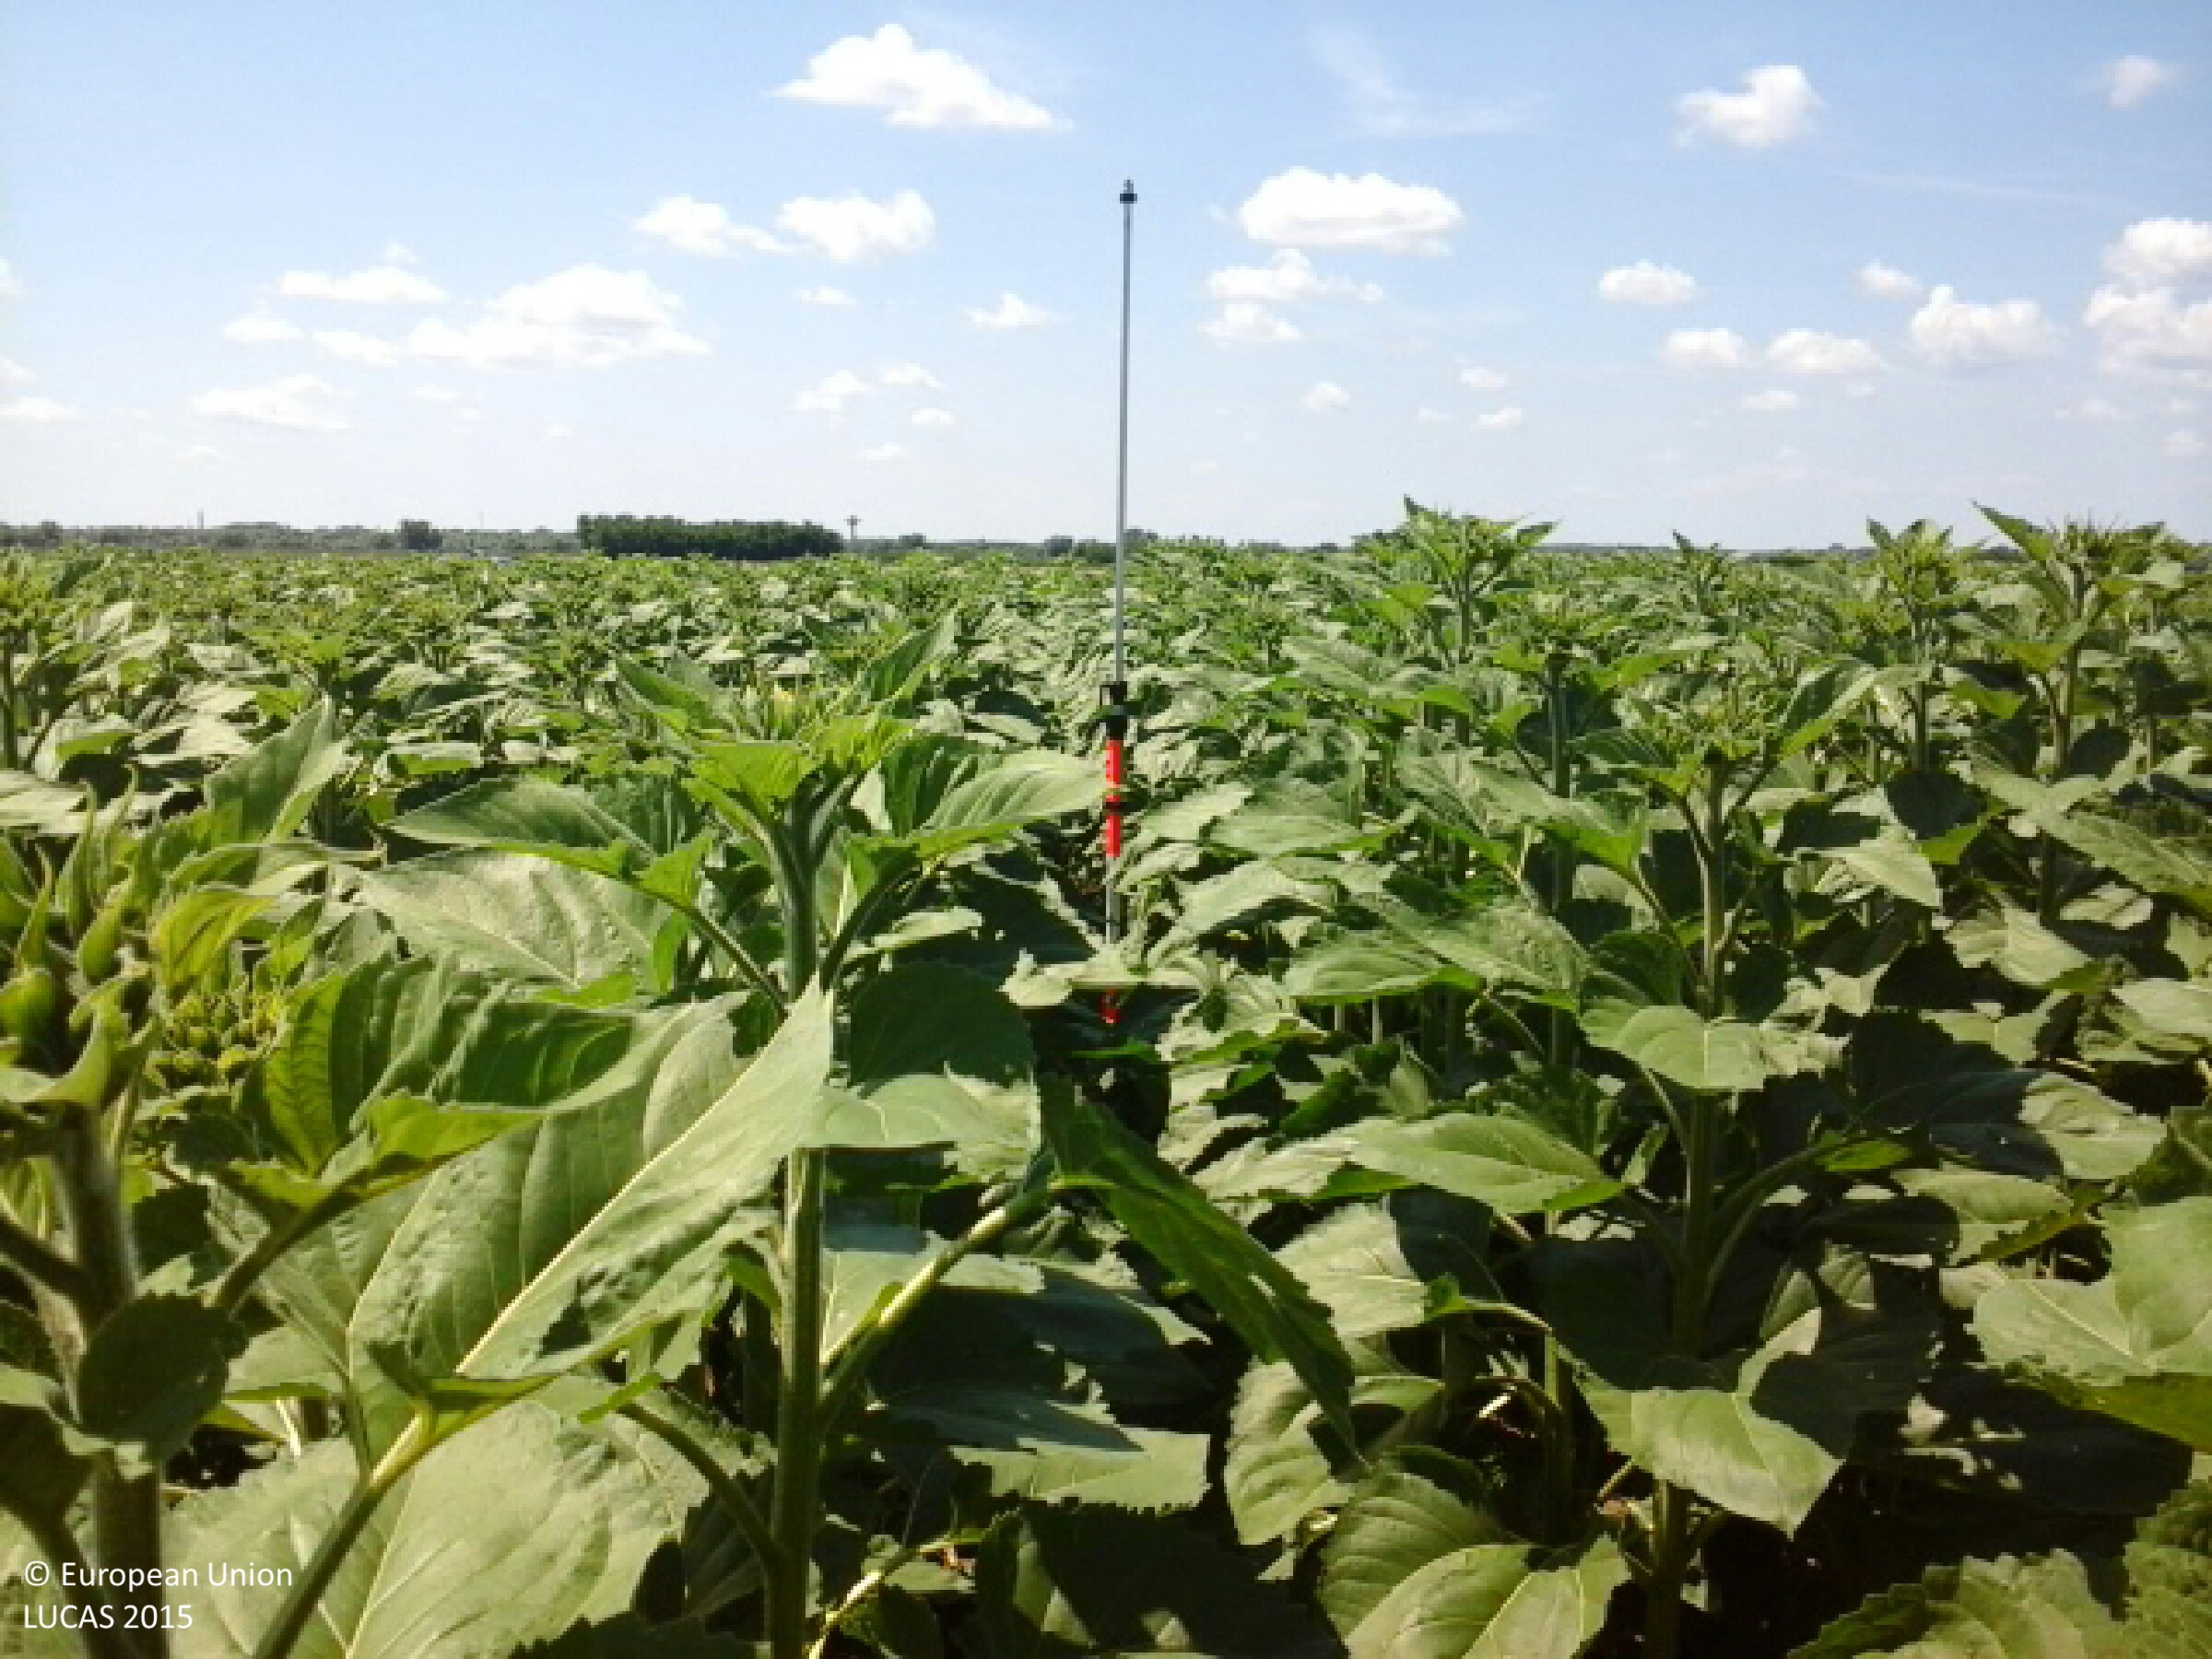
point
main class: Cropland
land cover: Sunflower
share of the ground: > 75 %
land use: Agriculture (excluding fallow land and kitchen gardens)
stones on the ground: < 10 %
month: July
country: HU
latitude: 47.9611
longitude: 22.3650
